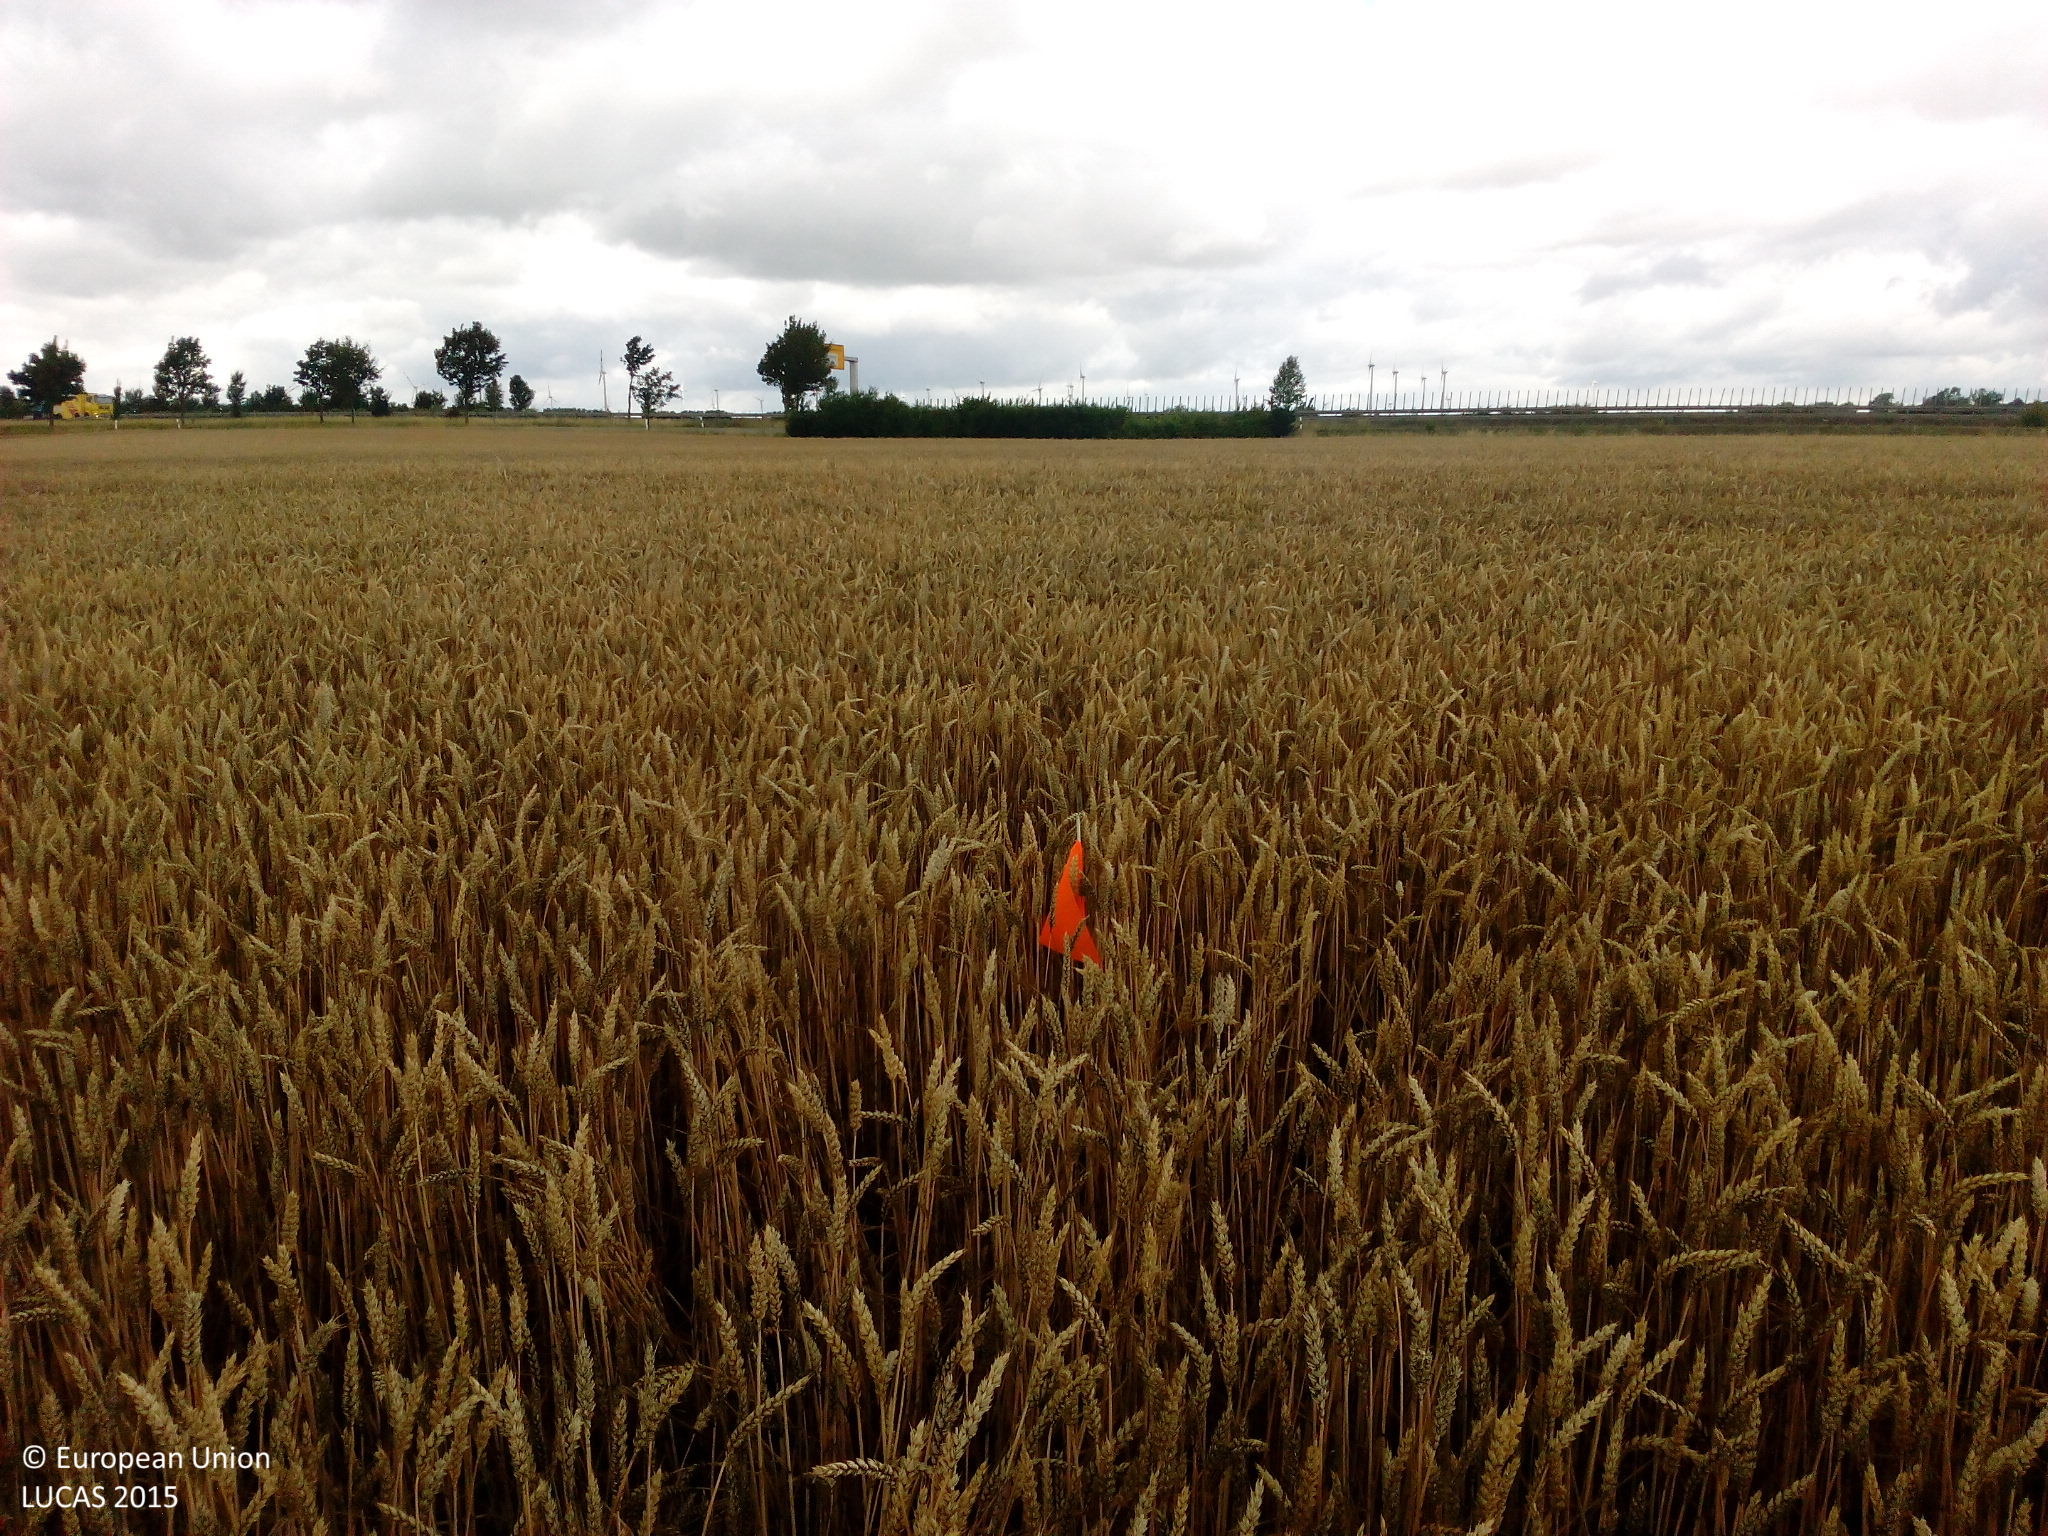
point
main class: Cropland
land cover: Common wheat
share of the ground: > 75 %
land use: Agriculture (excluding fallow land and kitchen gardens)
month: July
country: DE
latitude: 51.7745
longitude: 11.5214
